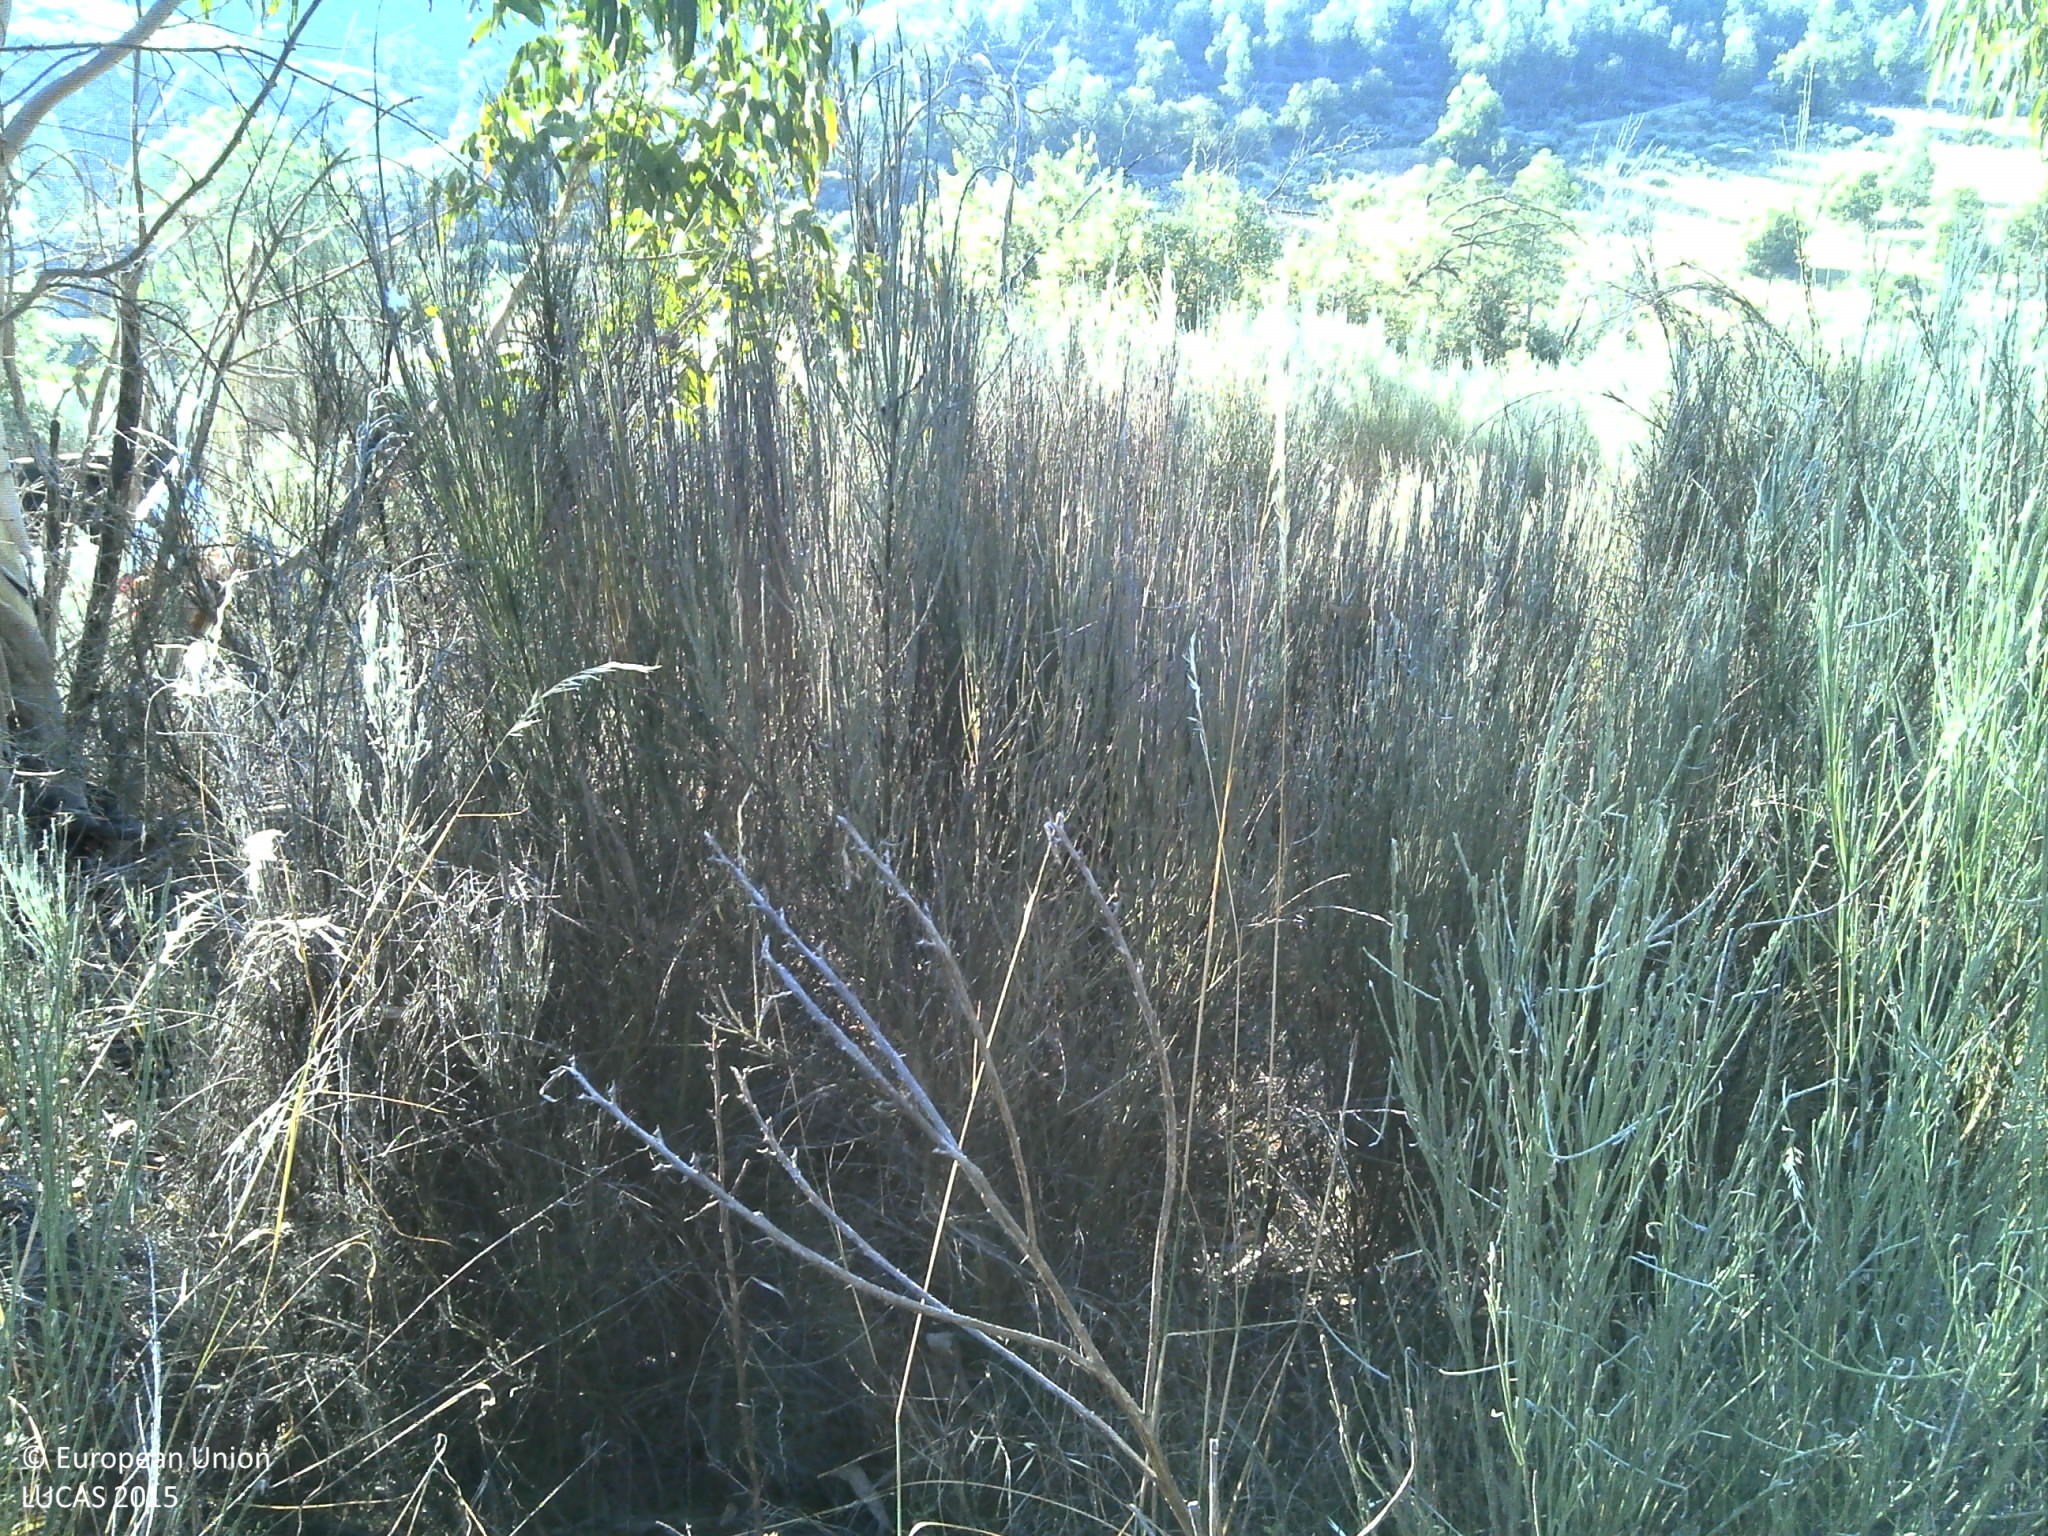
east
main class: Woodland
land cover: Broadleaved woodland
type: exotic forest
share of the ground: 25 - 50 %
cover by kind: broadleaved forest trees 50 %, shrubs 40 %, unconsolidated bare surface 10 %
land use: Forestry
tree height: > 5 m
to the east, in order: Broadleaved woodland; Tracks; Shrubland with sparse tree cover; Grass margins; Tracks; Other fruit trees and berries; Fences; Dry stone walls; Maize
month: June
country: PT
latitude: 40.8381
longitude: -7.1986
